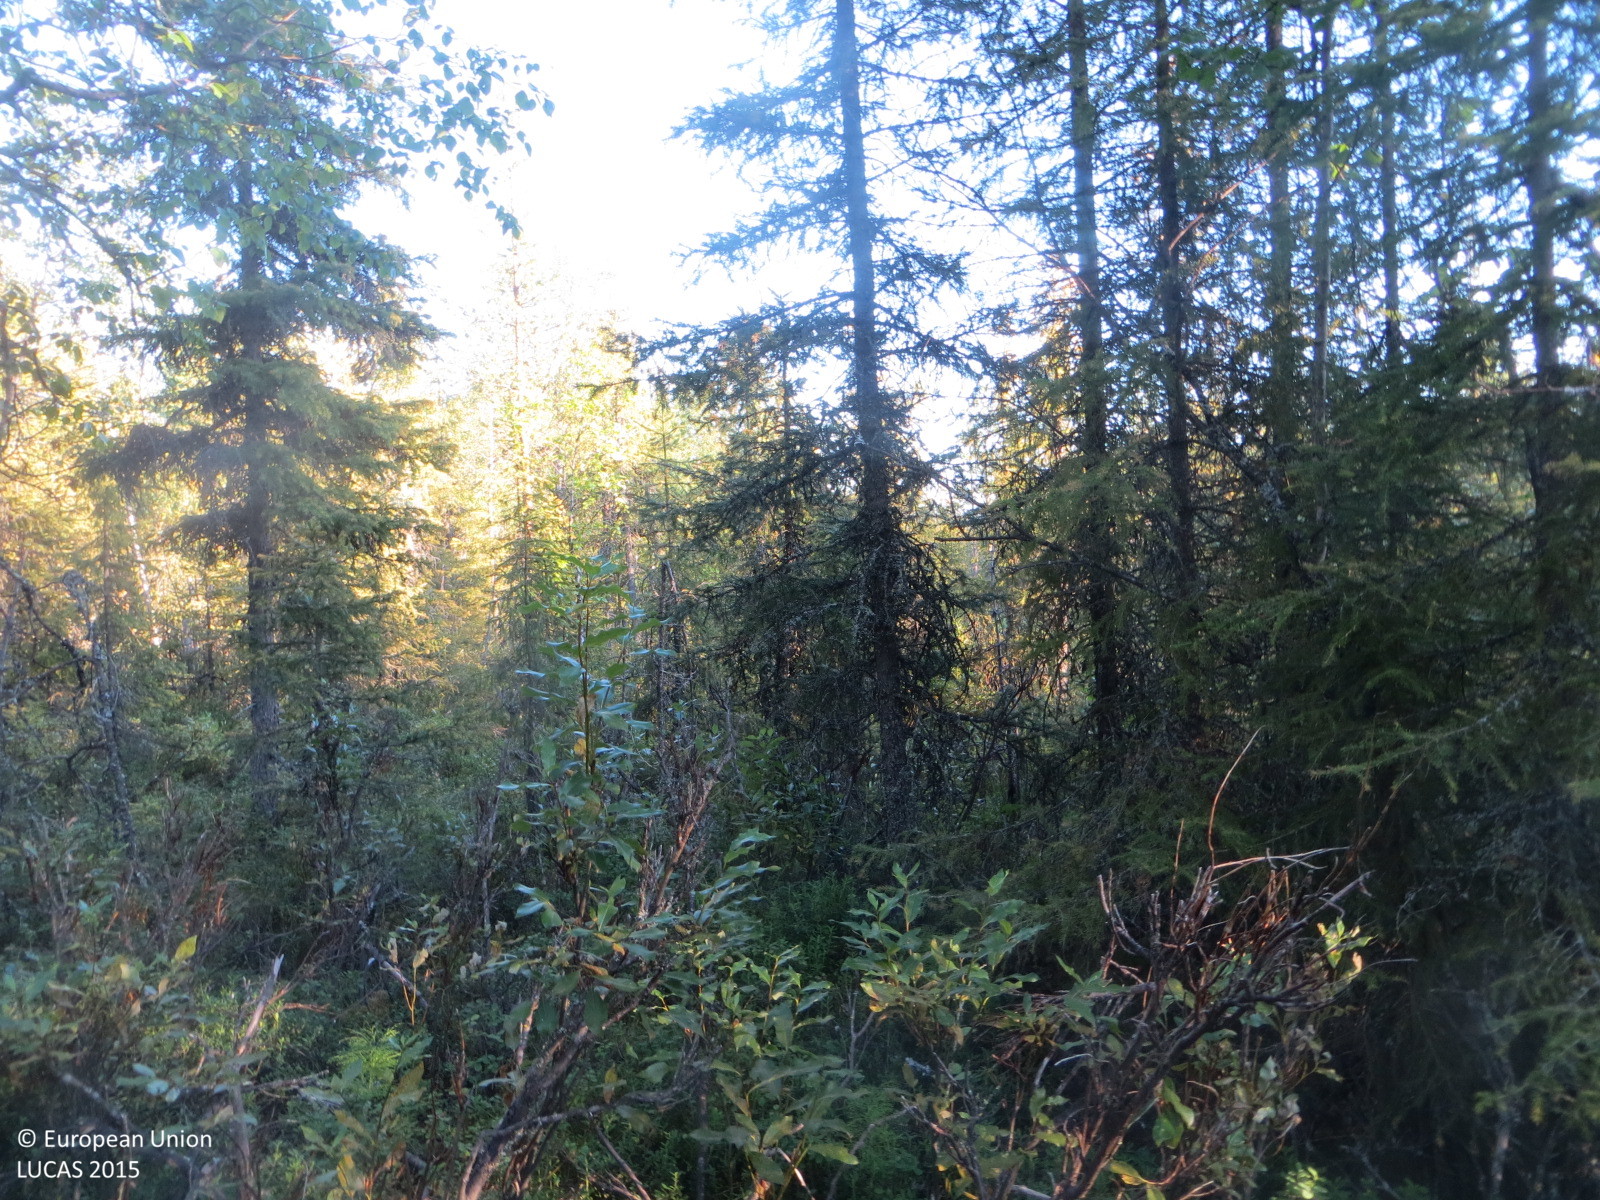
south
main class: Woodland
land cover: Spruce dominated mixed woodland
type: boreal forest
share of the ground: > 75 %
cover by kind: broadleaved forest trees 45 %, coniferous forest trees 30 %, shrubs 25 %
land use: Forestry
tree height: > 5 m
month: August
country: FI
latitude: 67.0352
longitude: 24.0170
